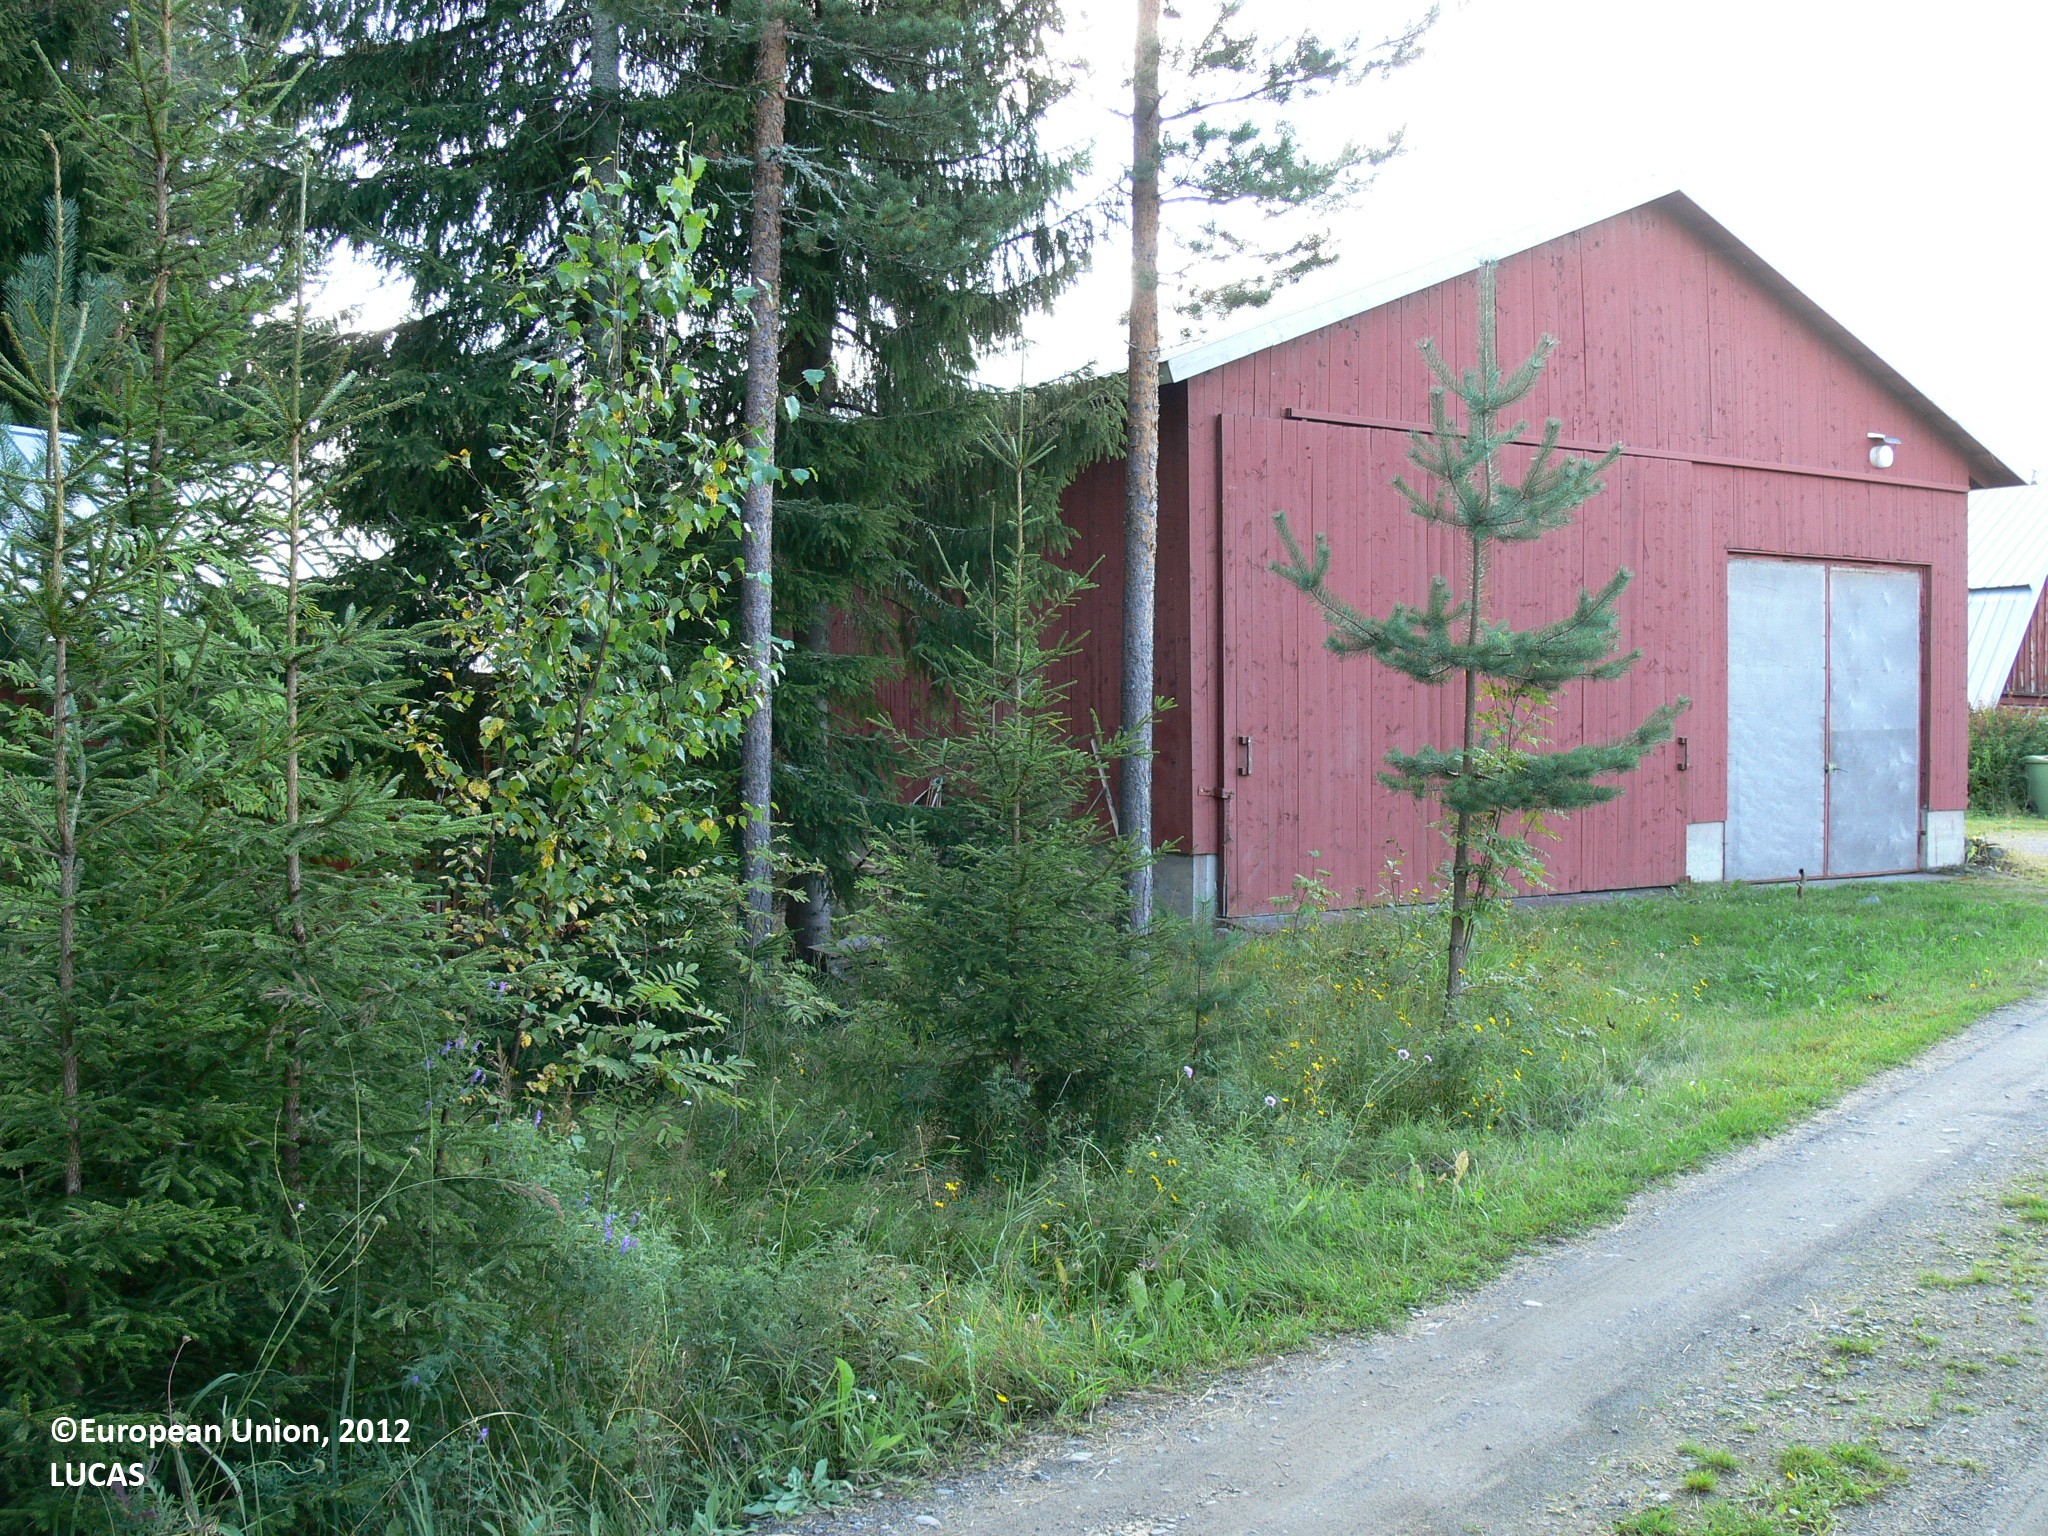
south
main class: Cropland
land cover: Temporary grasslands
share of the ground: > 75 %
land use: Agriculture (excluding fallow land and kitchen gardens)
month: August
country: FI
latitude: 62.0724
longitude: 30.1179
